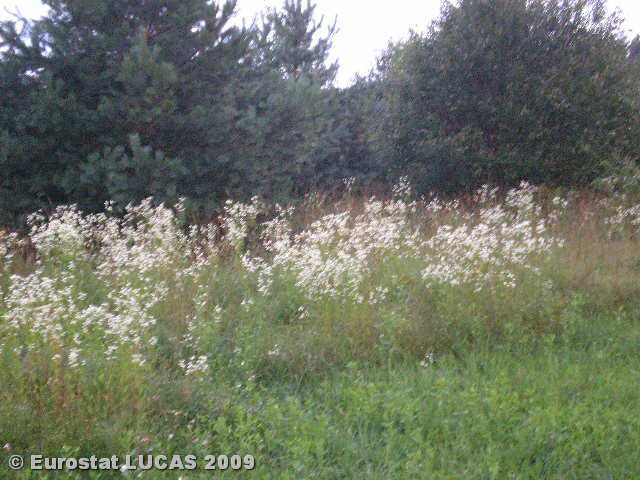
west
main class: Grassland
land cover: Grassland with sparse tree/shrub cover
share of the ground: > 75 %
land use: Residential
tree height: > 5 m
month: July
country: LT
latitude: 54.7800
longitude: 25.3441
